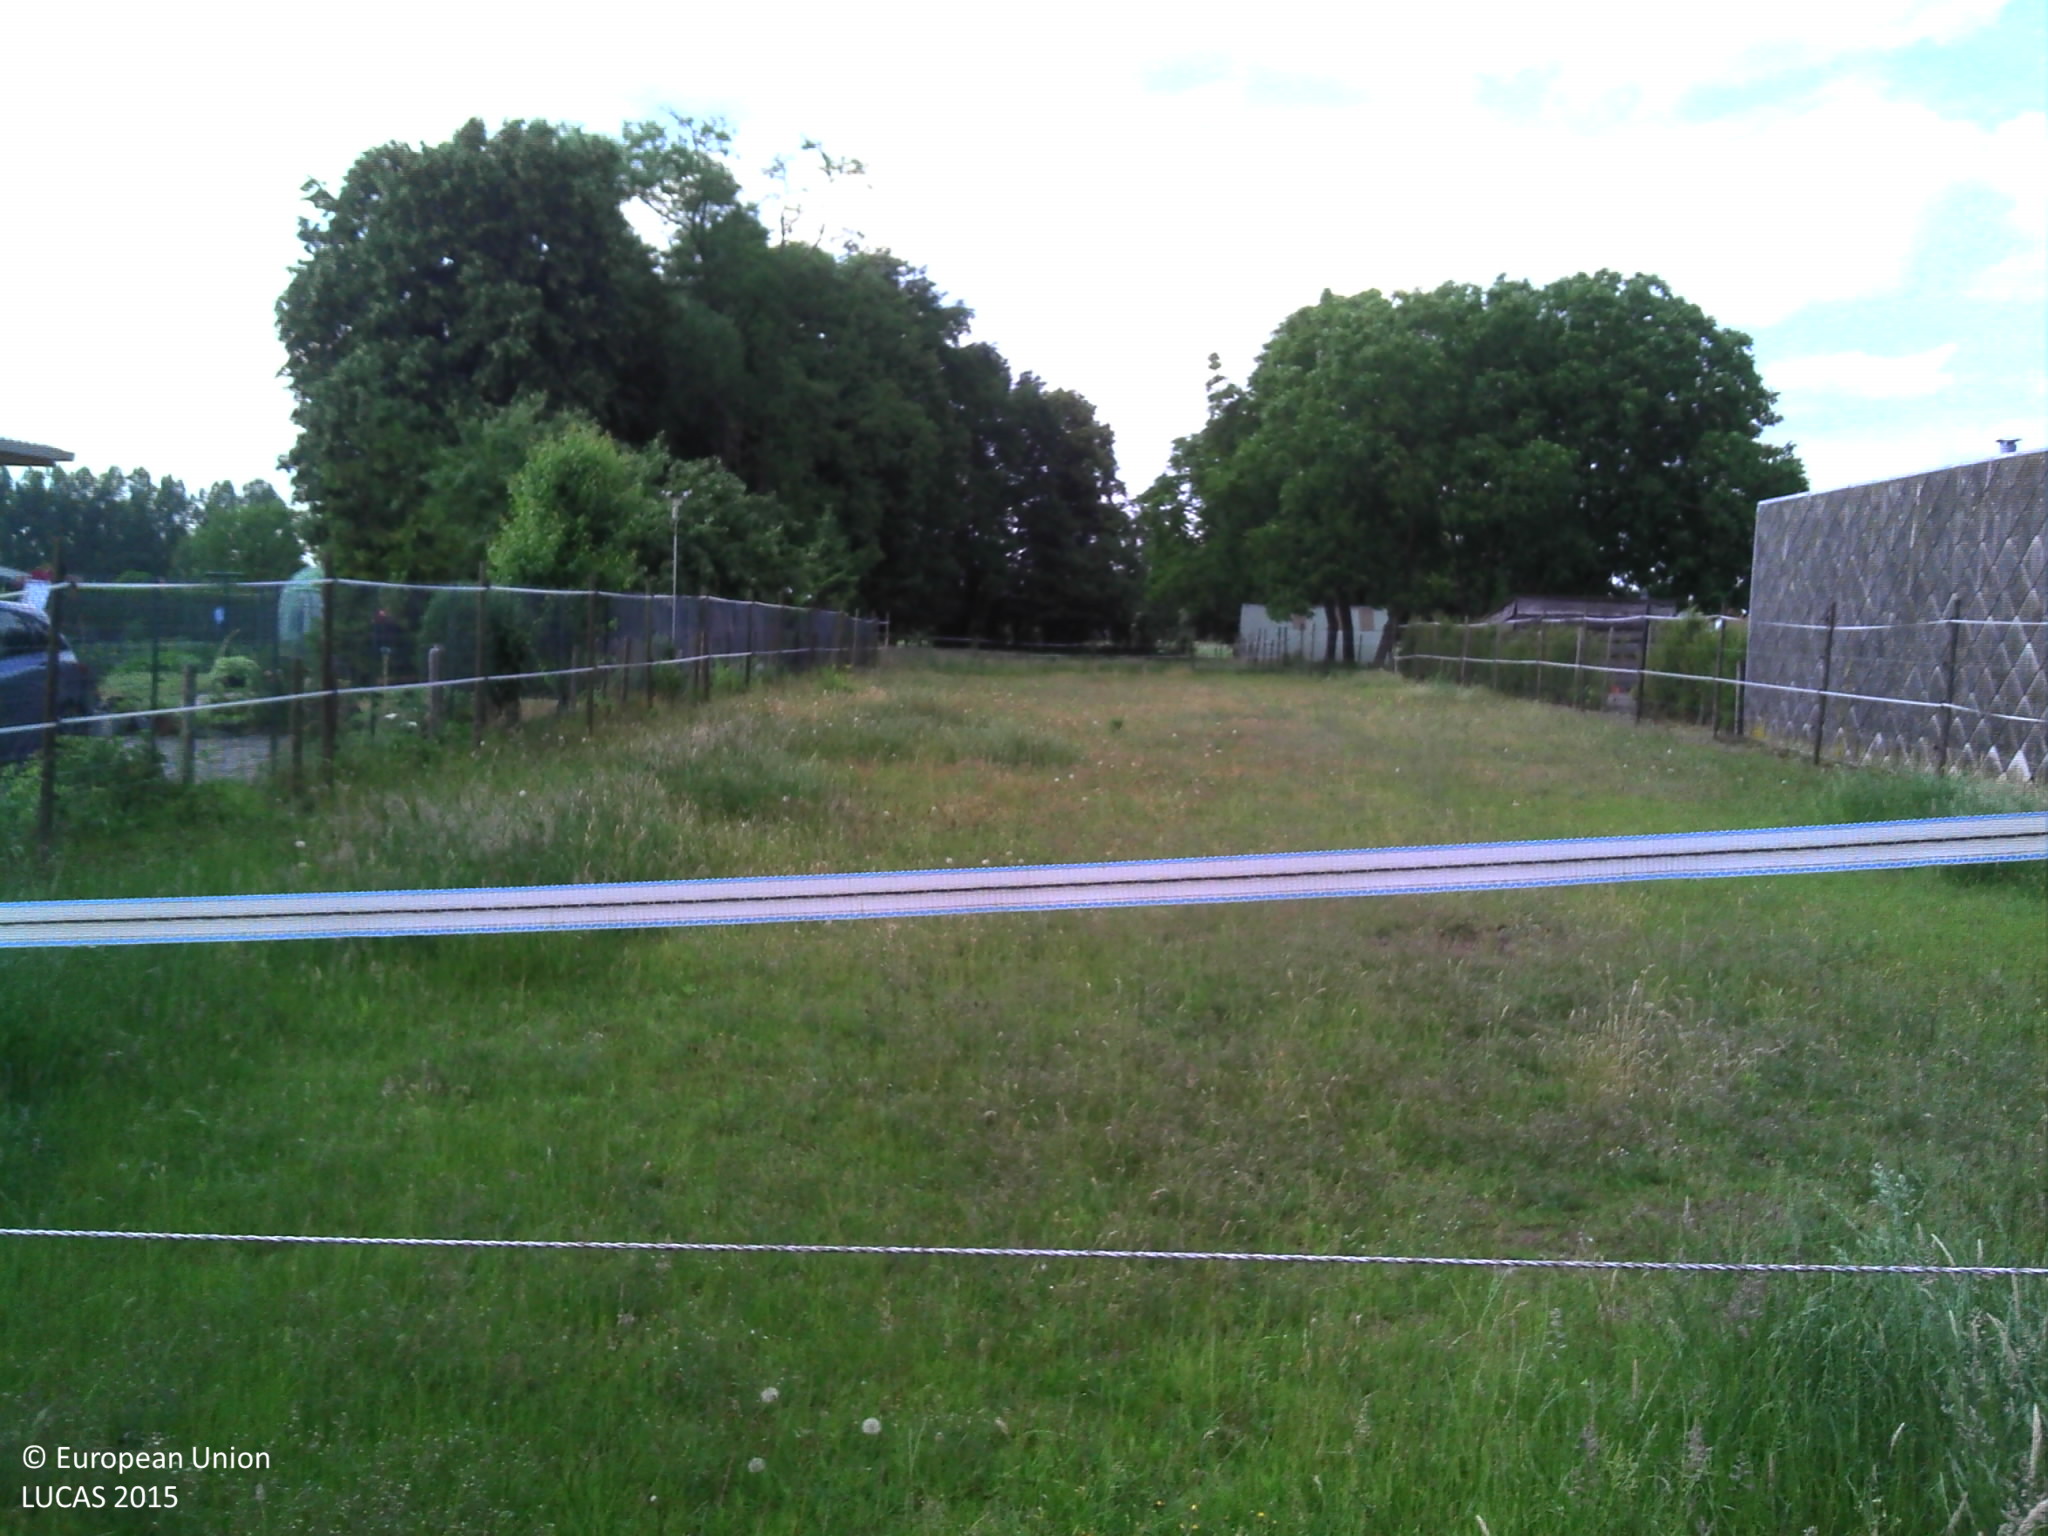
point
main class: Grassland
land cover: Grassland without tree/shrub cover
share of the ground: > 75 %
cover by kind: herbaceous plants 100 %
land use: Agriculture (excluding fallow land and kitchen gardens)
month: June
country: BE
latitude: 51.0623
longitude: 3.8150
